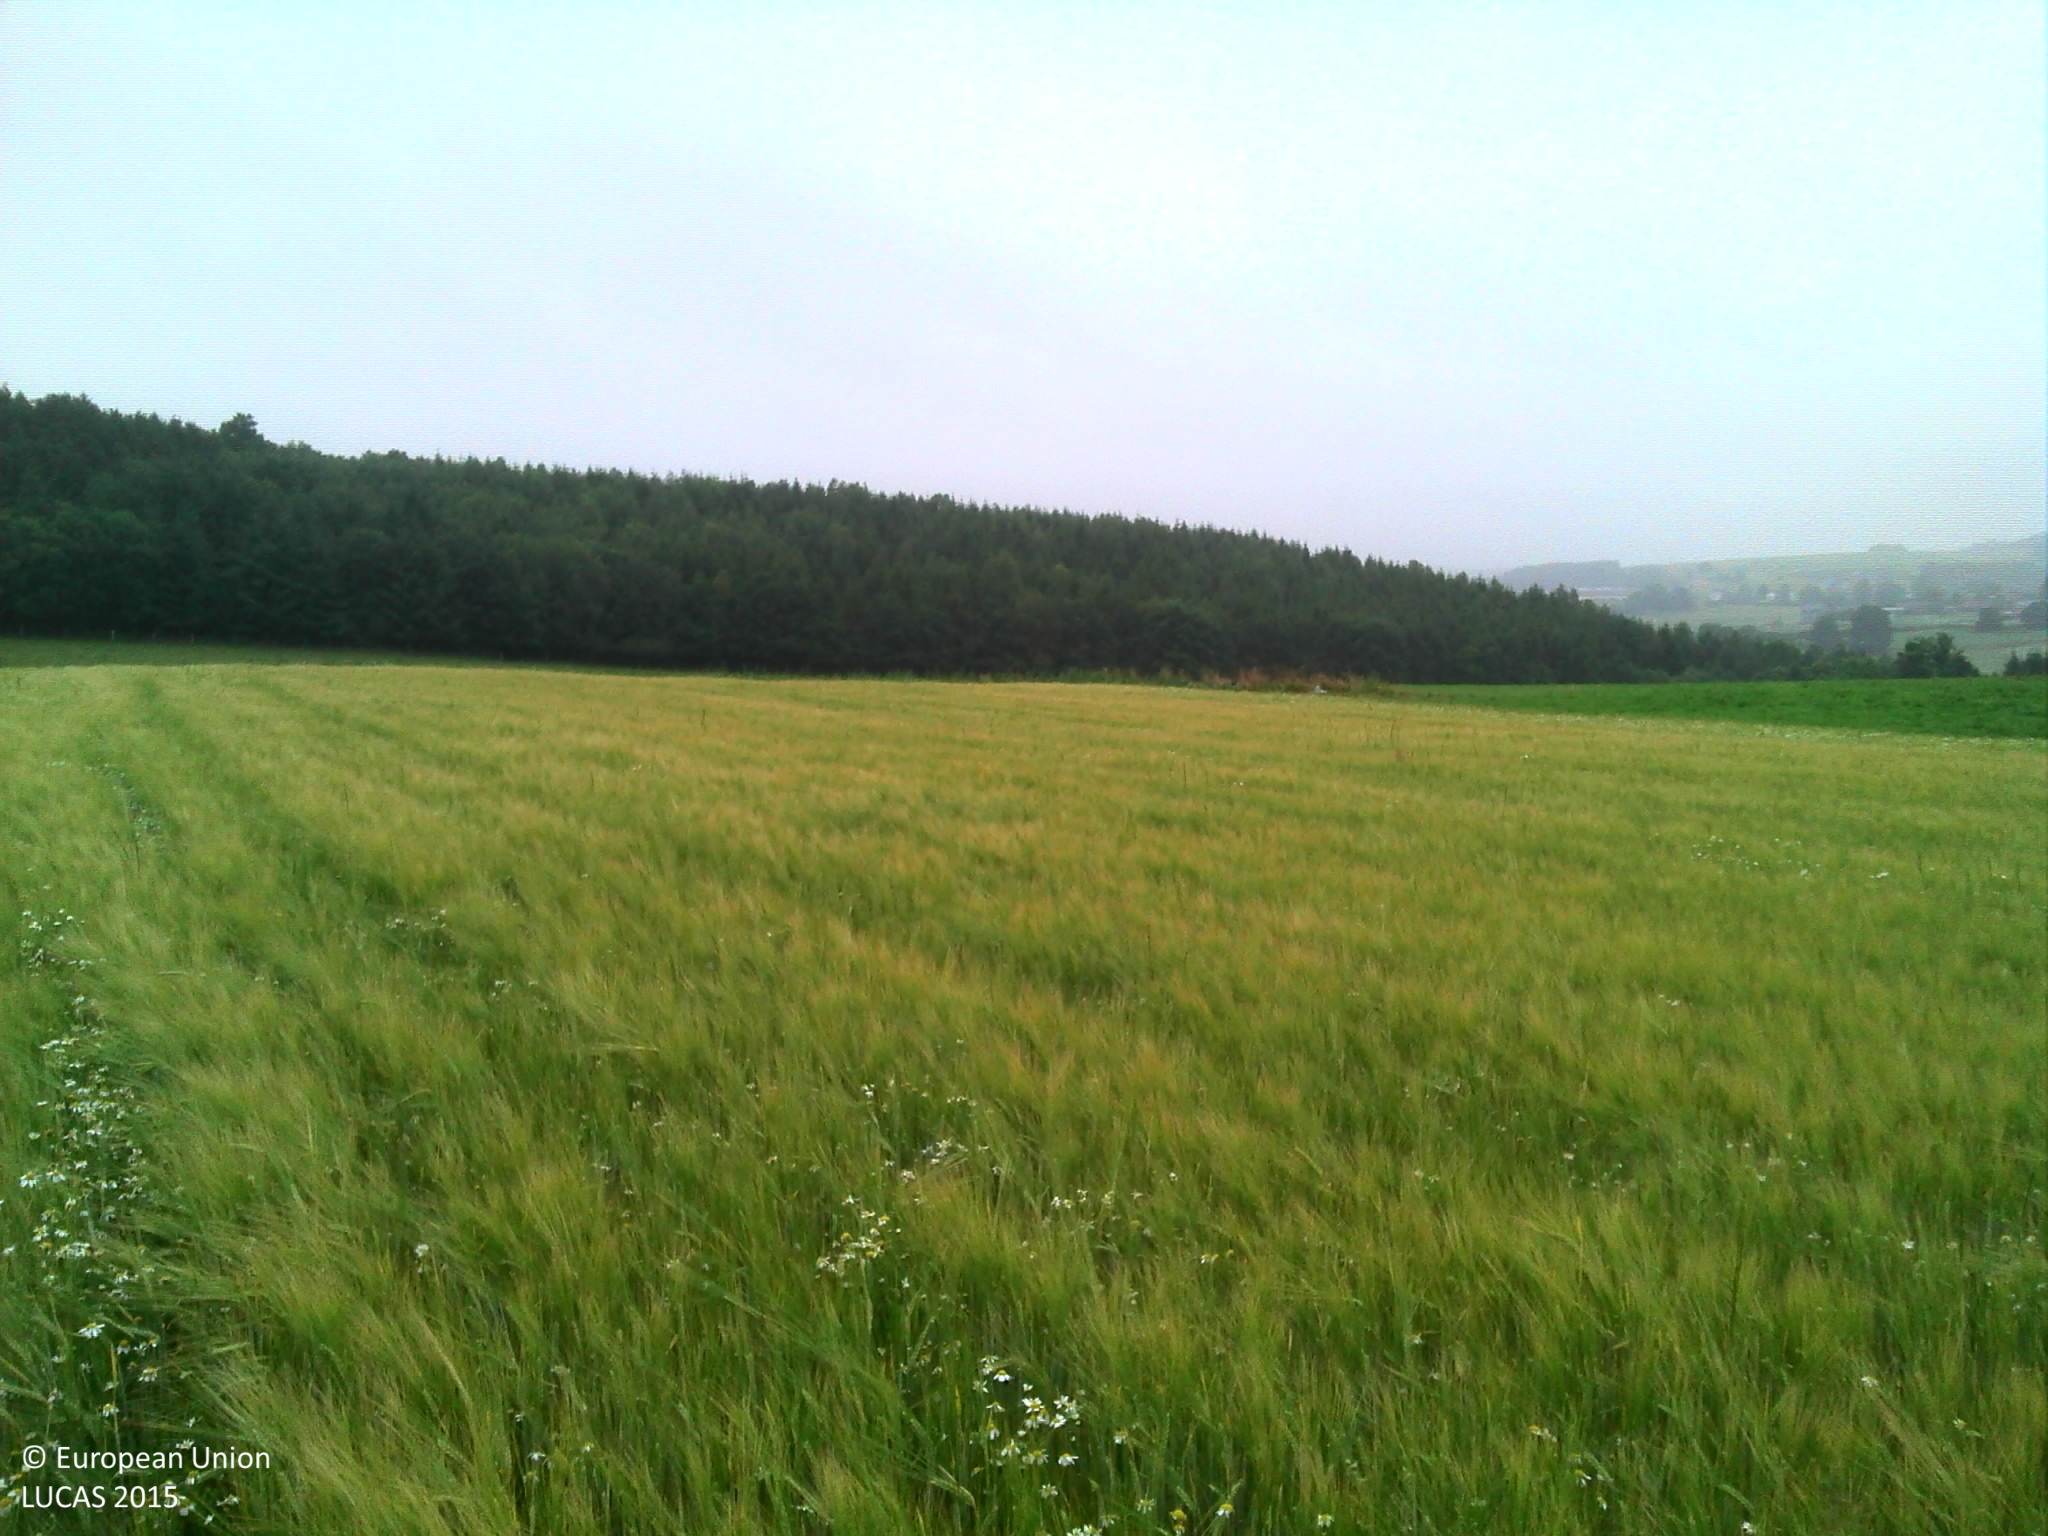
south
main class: Cropland
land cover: Barley
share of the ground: > 75 %
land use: Agriculture (excluding fallow land and kitchen gardens)
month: July
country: BE
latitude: 50.0654
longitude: 5.6539
